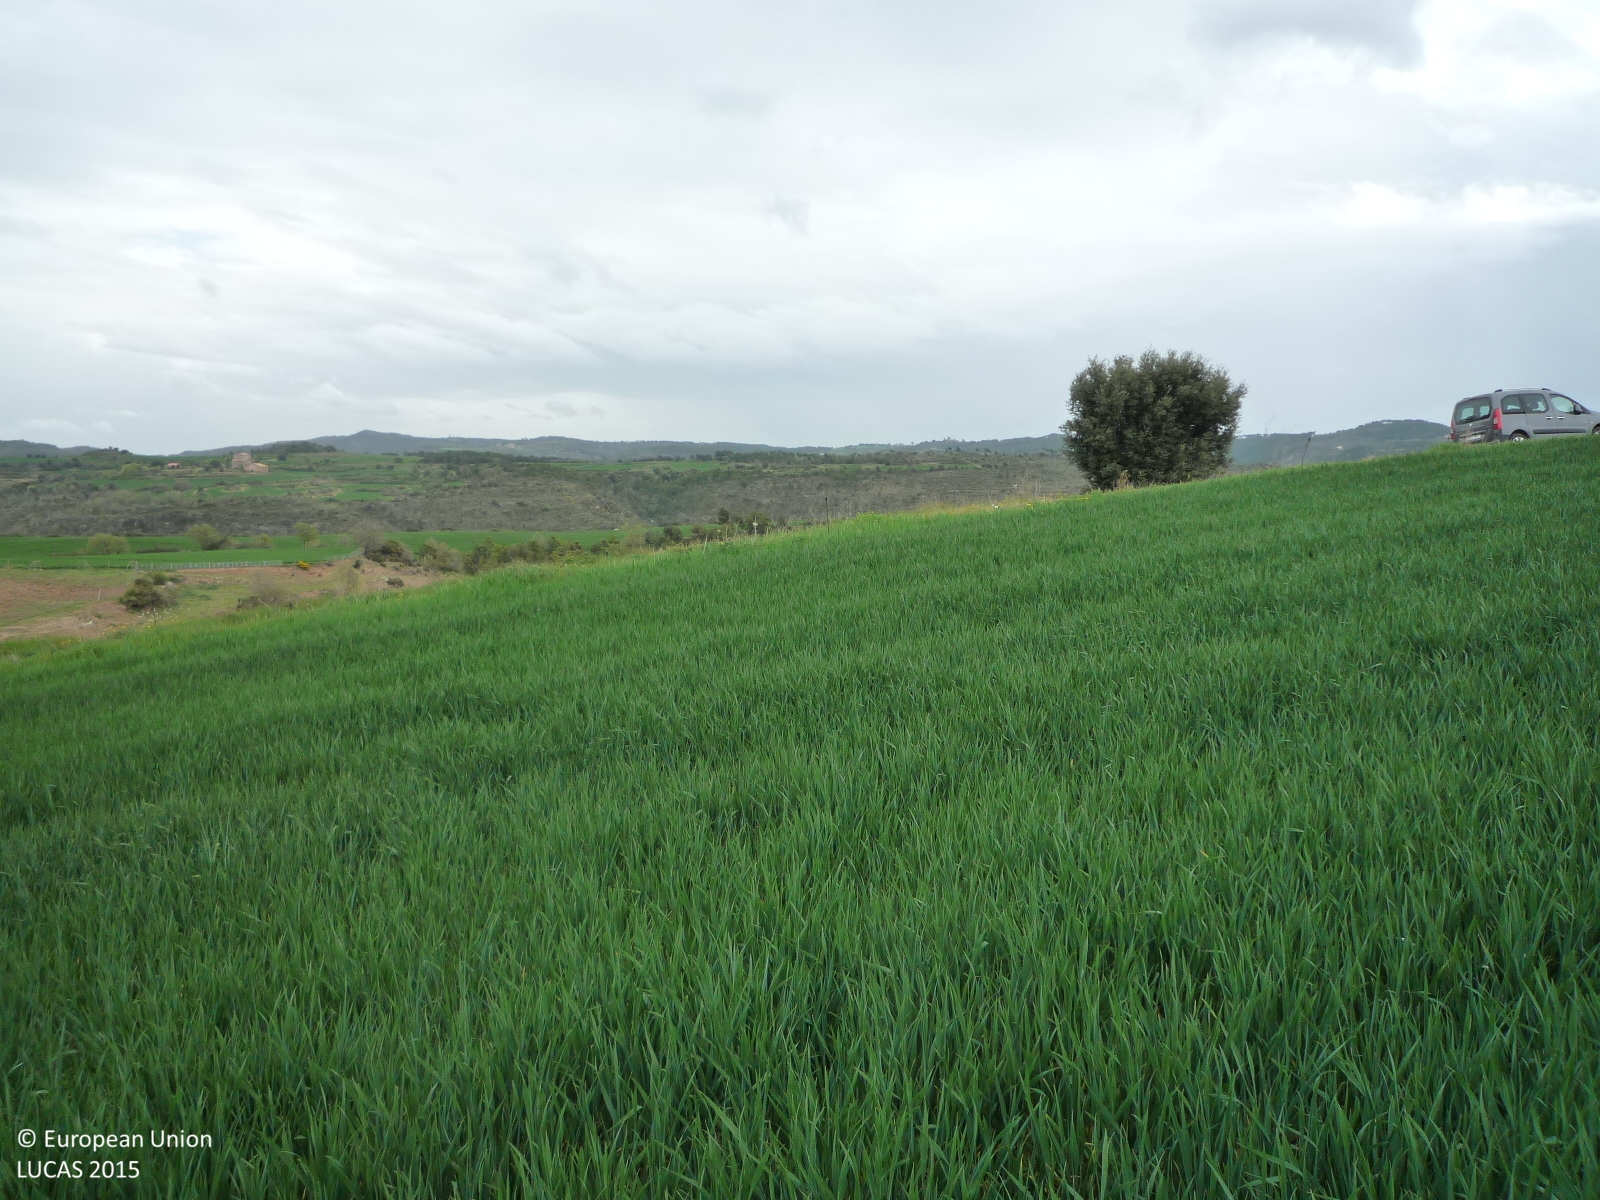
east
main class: Cropland
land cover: Common wheat
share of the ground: > 75 %
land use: Agriculture (excluding fallow land and kitchen gardens)
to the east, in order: Common wheat; Grass margins; Fences; Grass margins; Paved roads, cycling and walking lanes; Grass margins; Fences; Grass margins; Barley; Shruby margins; Barley; Fences; Shrubland with sparse tree cover; Dry stone walls; Shrubland with sparse tree cover; Tracks; Broadleaved woodland; Tracks; Rock outcrops
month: April
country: ES
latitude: 41.9520
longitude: 1.7257
